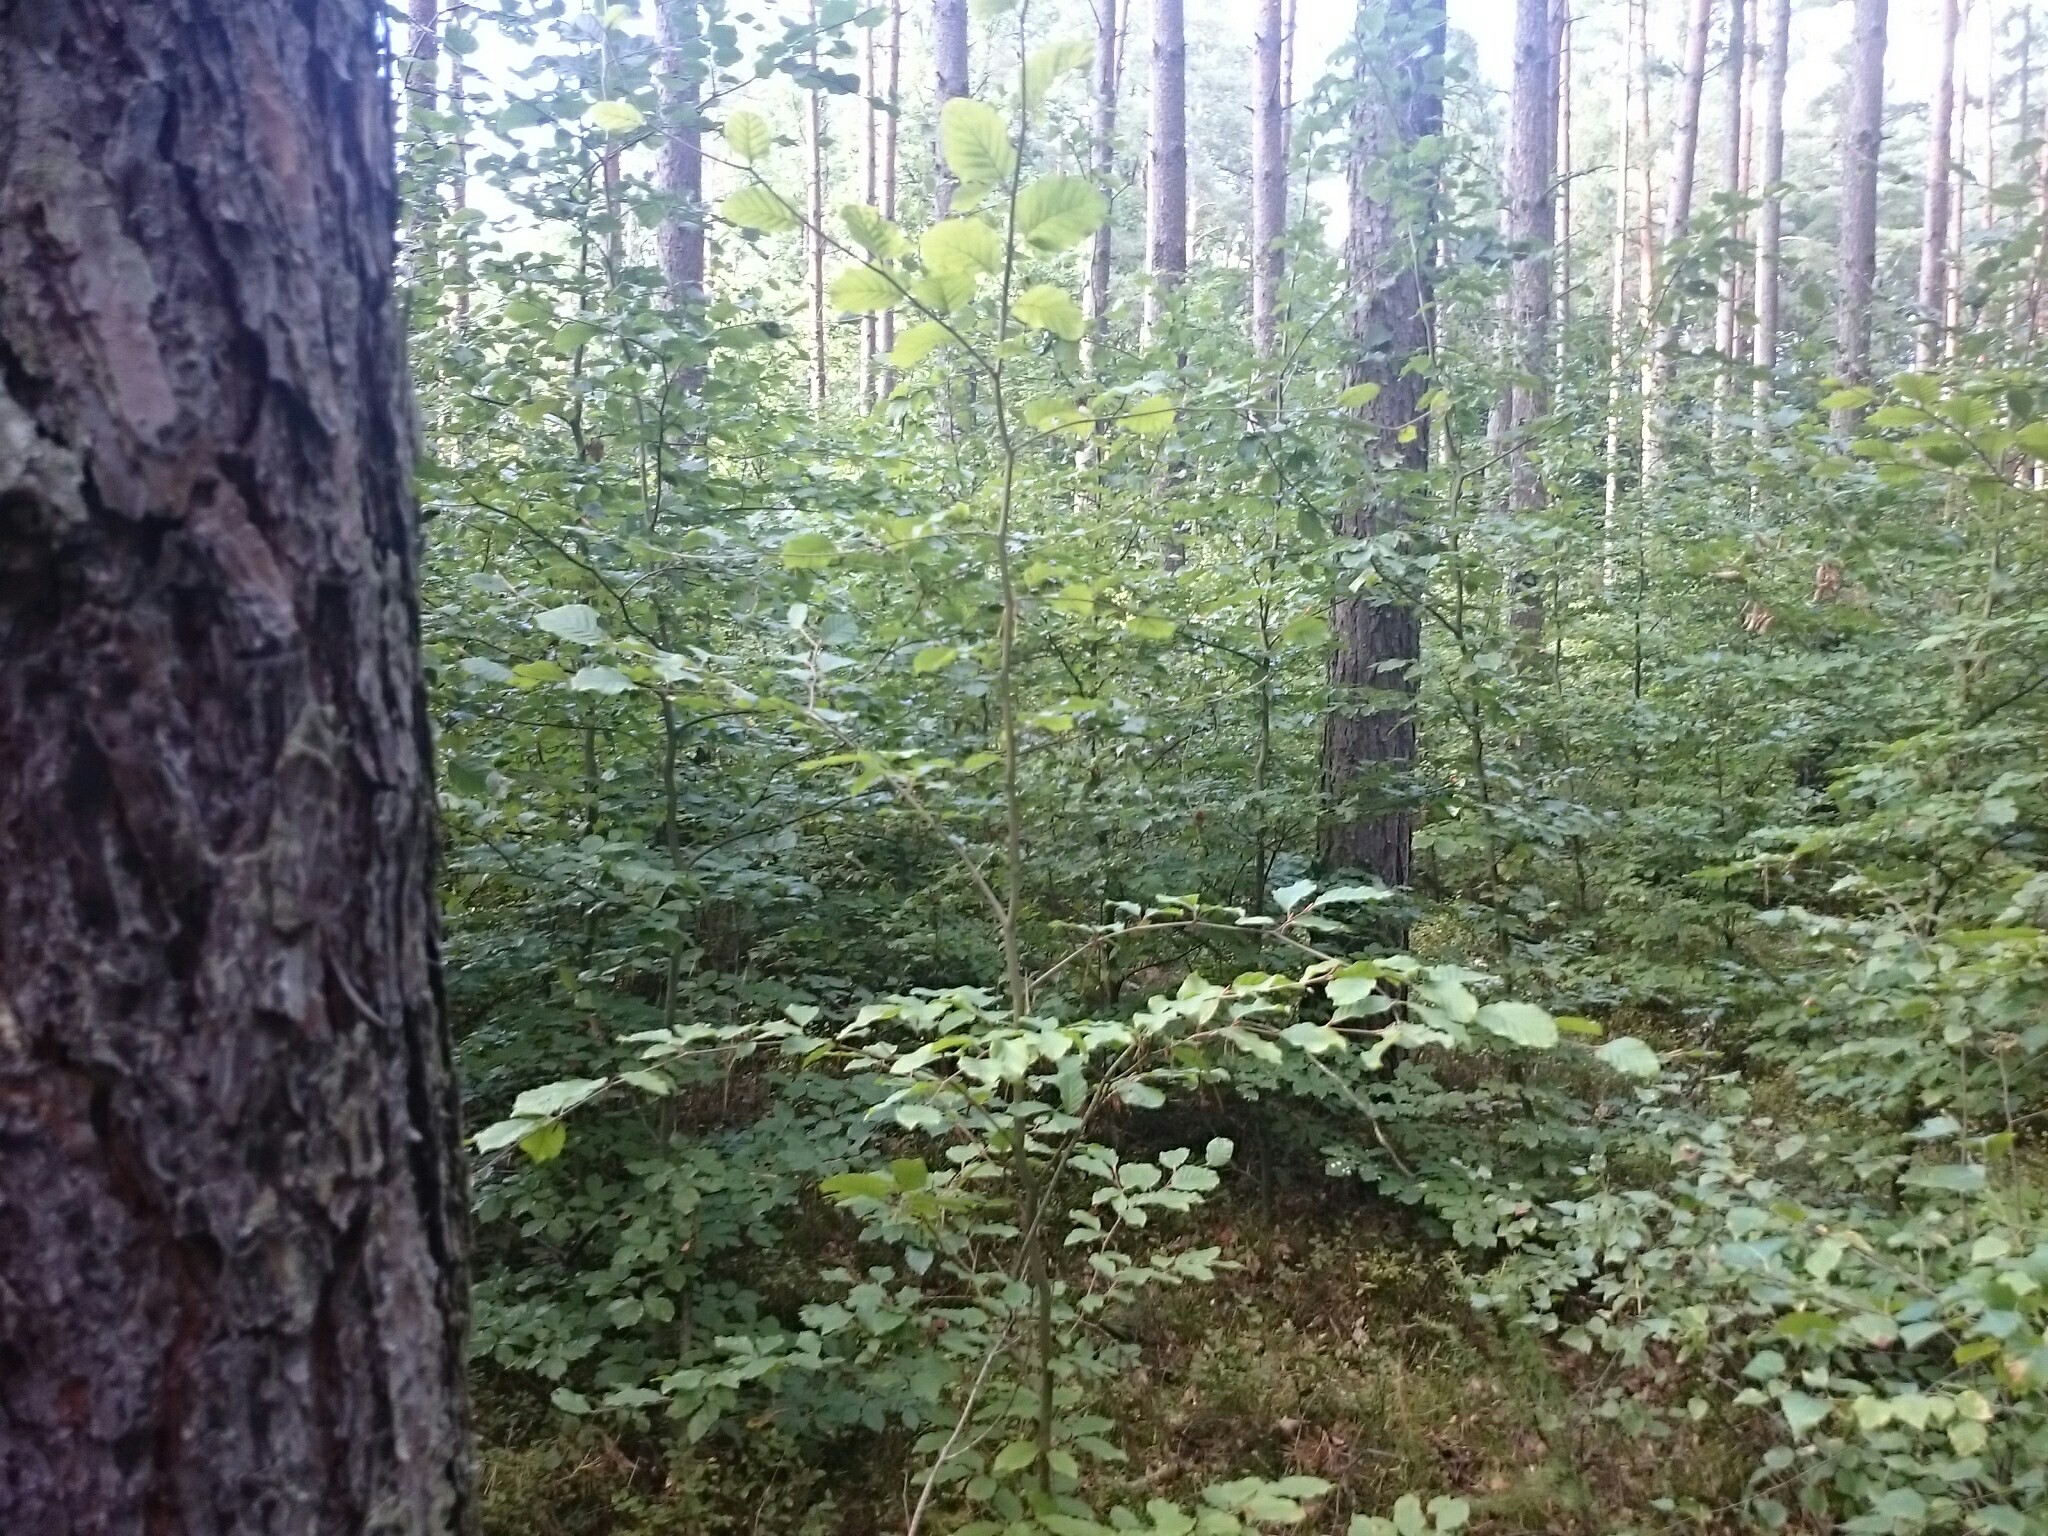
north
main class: Woodland
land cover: Pine dominated mixed woodland
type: hemiboreal forest and nemoral coniferous forest and mixed broadleaved-coniferous forest
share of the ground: > 75 %
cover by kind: coniferous forest trees 55 %, broadleaved forest trees 35 %, herbaceous plants 10 %
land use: Forestry
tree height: > 5 m
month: September
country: PL
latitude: 51.3749
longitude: 17.3242
